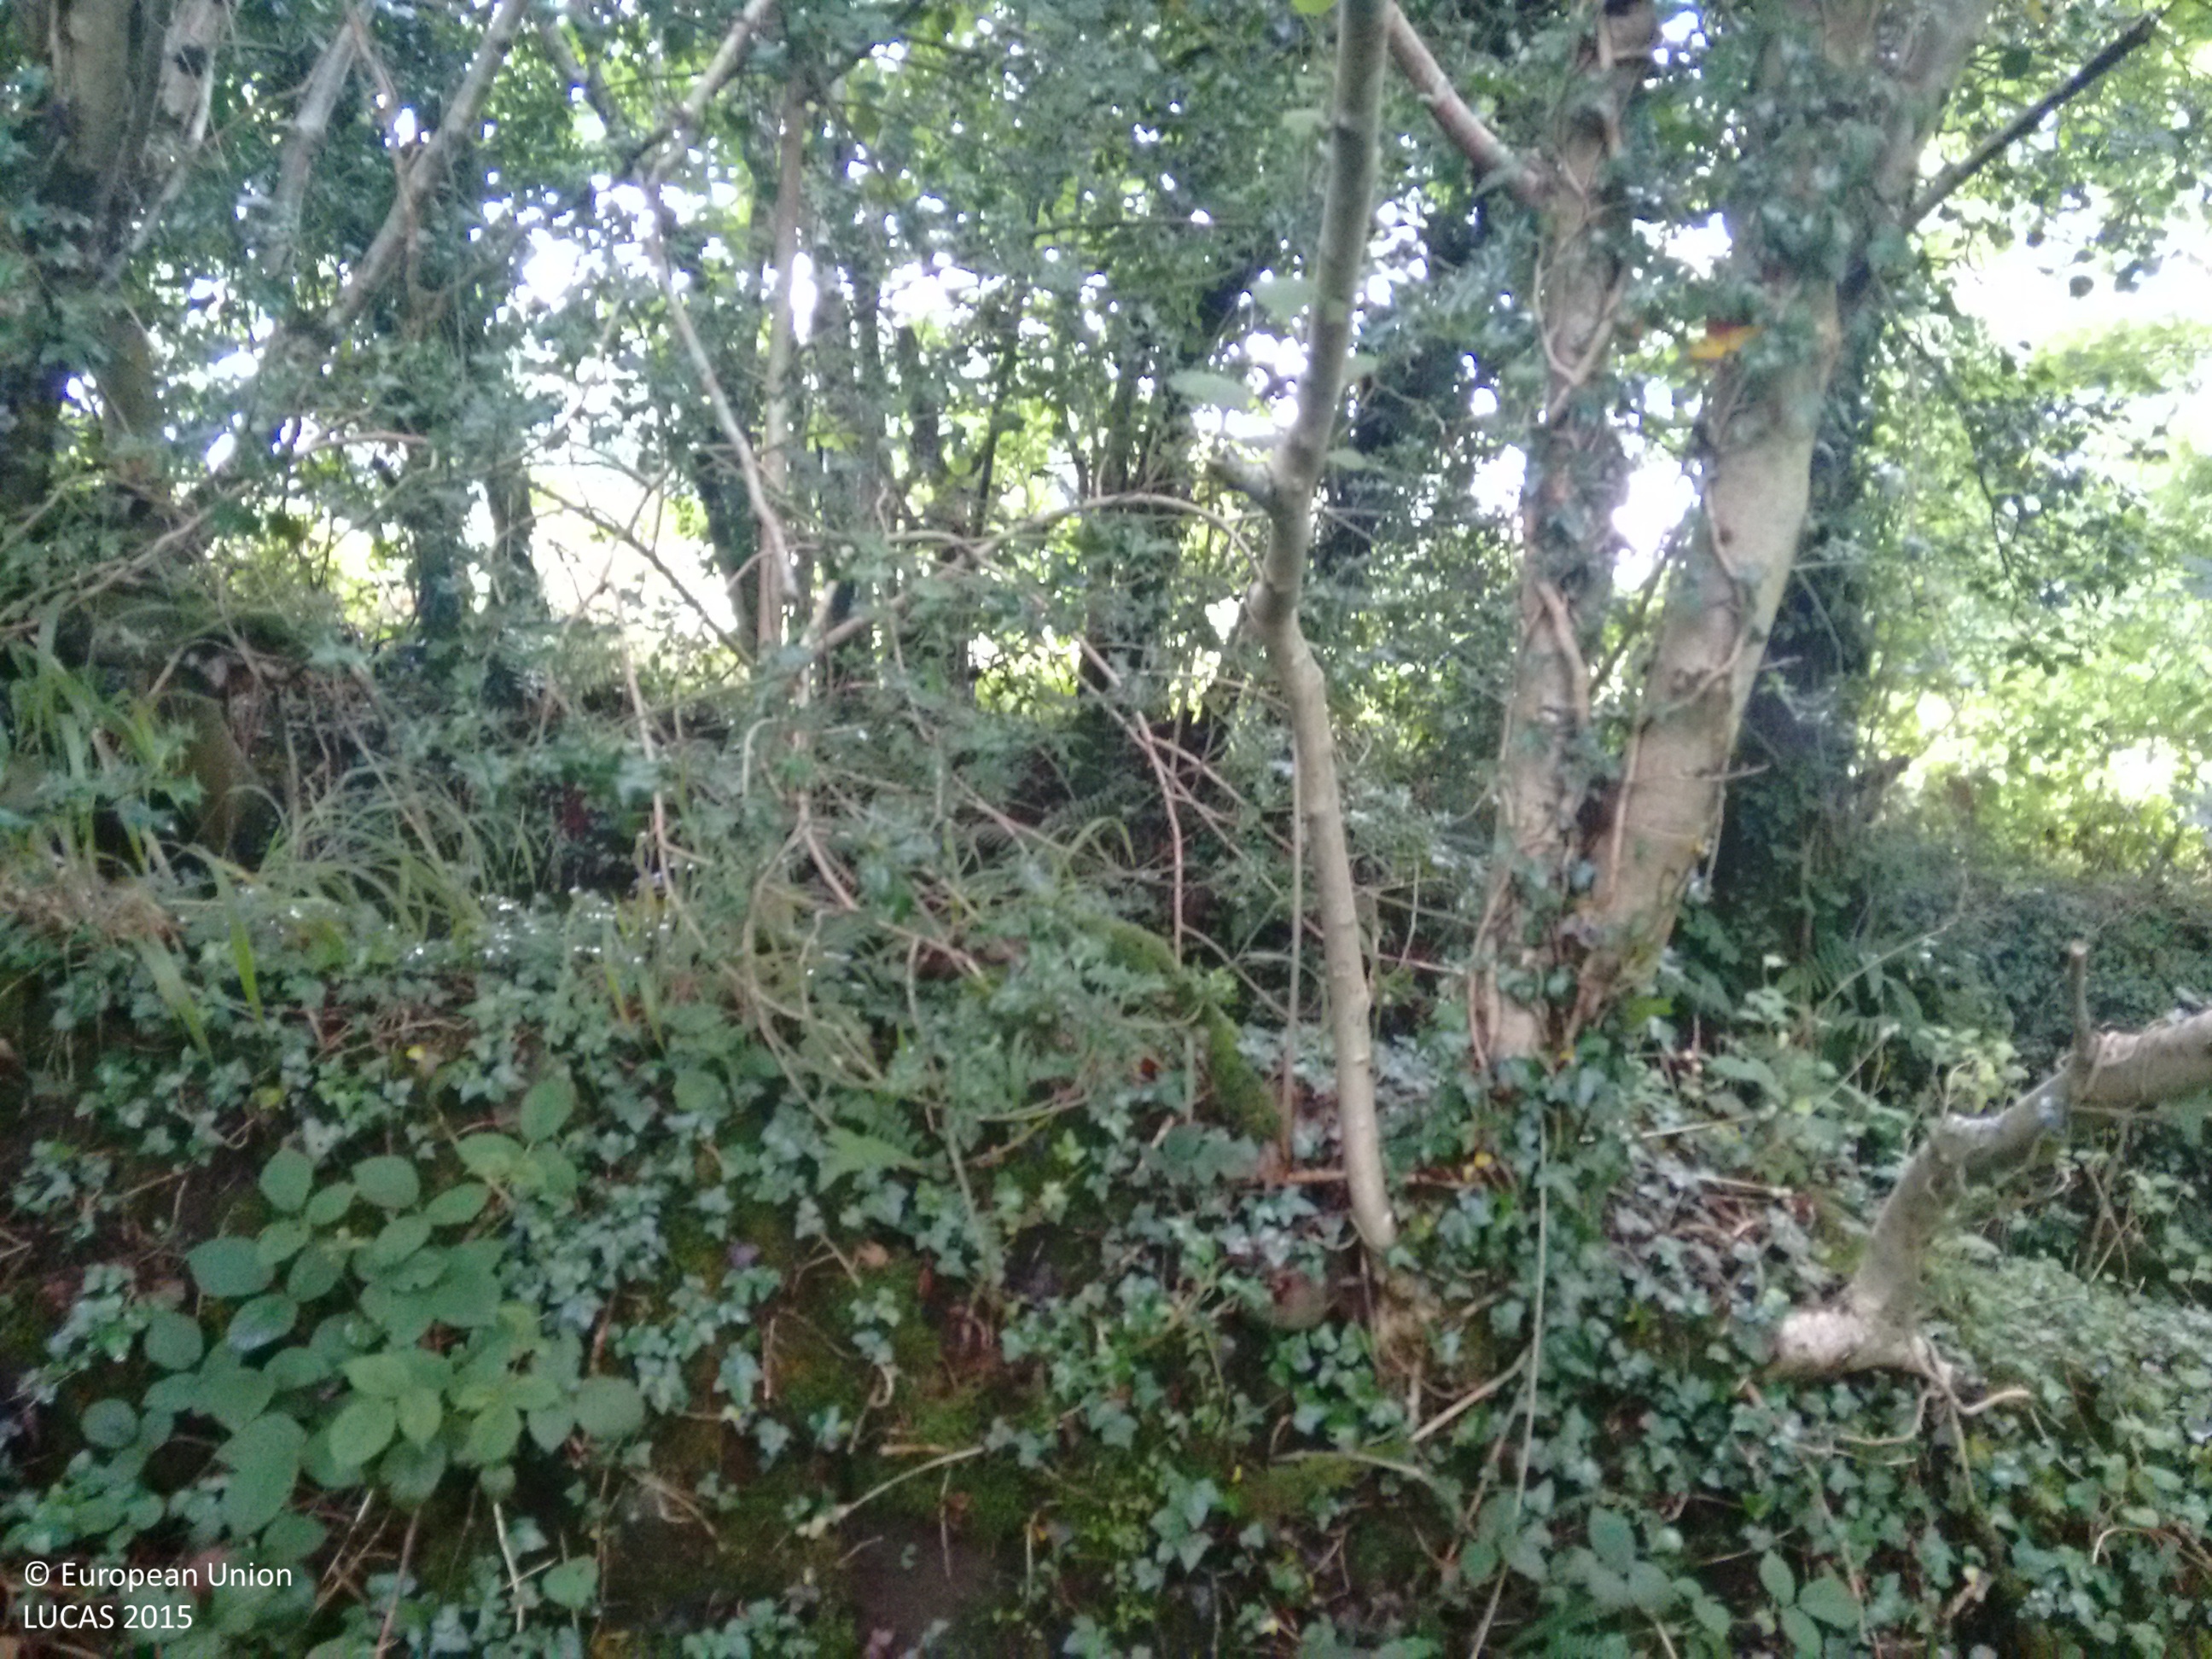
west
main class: Woodland
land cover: Broadleaved woodland
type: mesophytic deciduous forest
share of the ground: > 75 %
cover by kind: broadleaved forest trees 60 %, shrubs 40 %
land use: Semi-natural and natural areas not in use
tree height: > 5 m
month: August
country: GB
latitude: 51.7413
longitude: -4.7528
